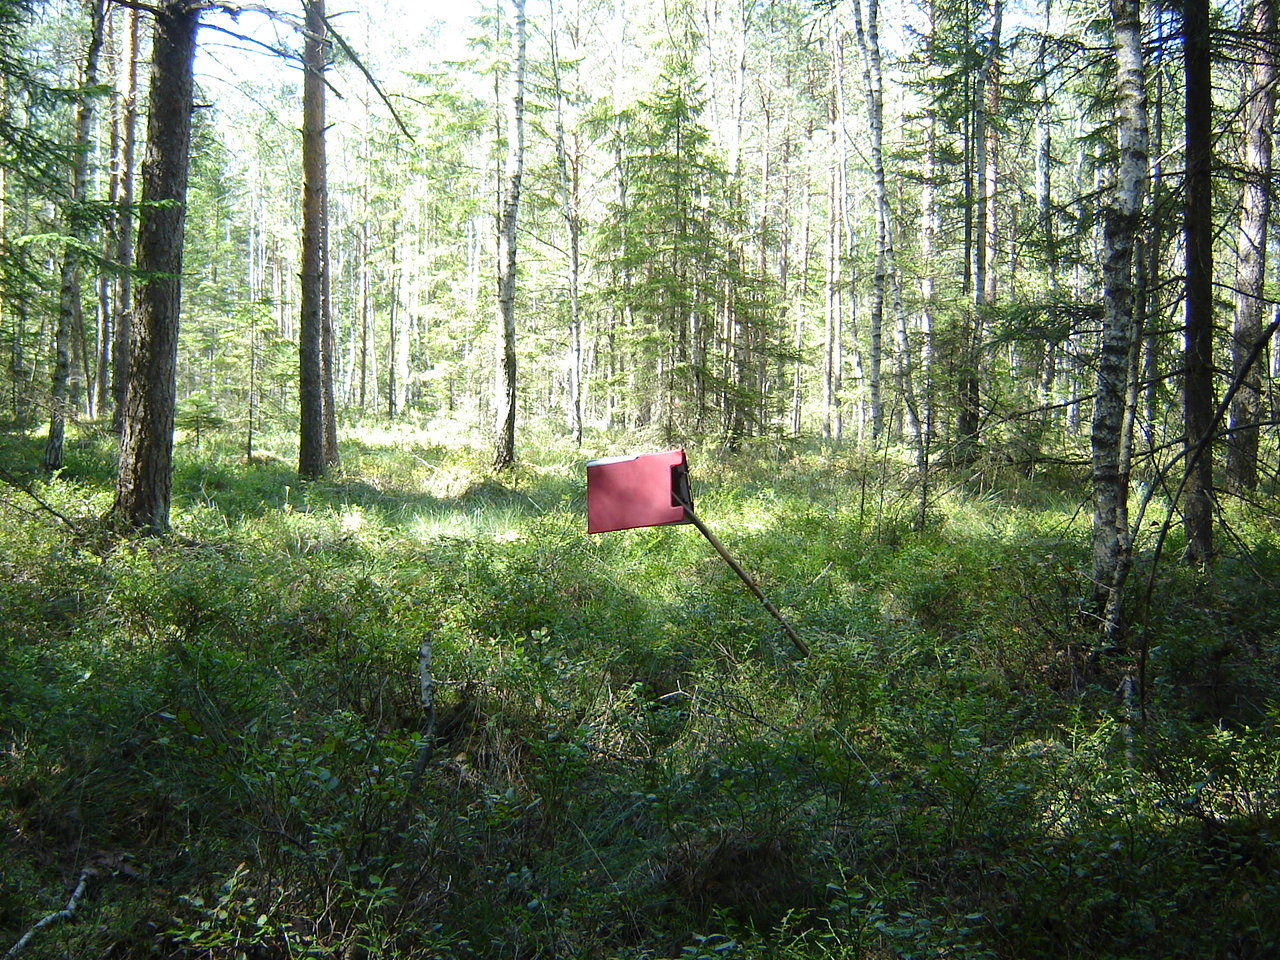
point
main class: Woodland
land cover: Pine dominated mixed woodland
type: hemiboreal forest and nemoral coniferous forest and mixed broadleaved-coniferous forest
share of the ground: > 75 %
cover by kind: coniferous forest trees 50 %, broadleaved forest trees 30 %, shrubs 10 %, herbaceous plants 10 %
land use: Forestry
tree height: > 5 m
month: August
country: LT
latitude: 54.8689
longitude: 25.2184
